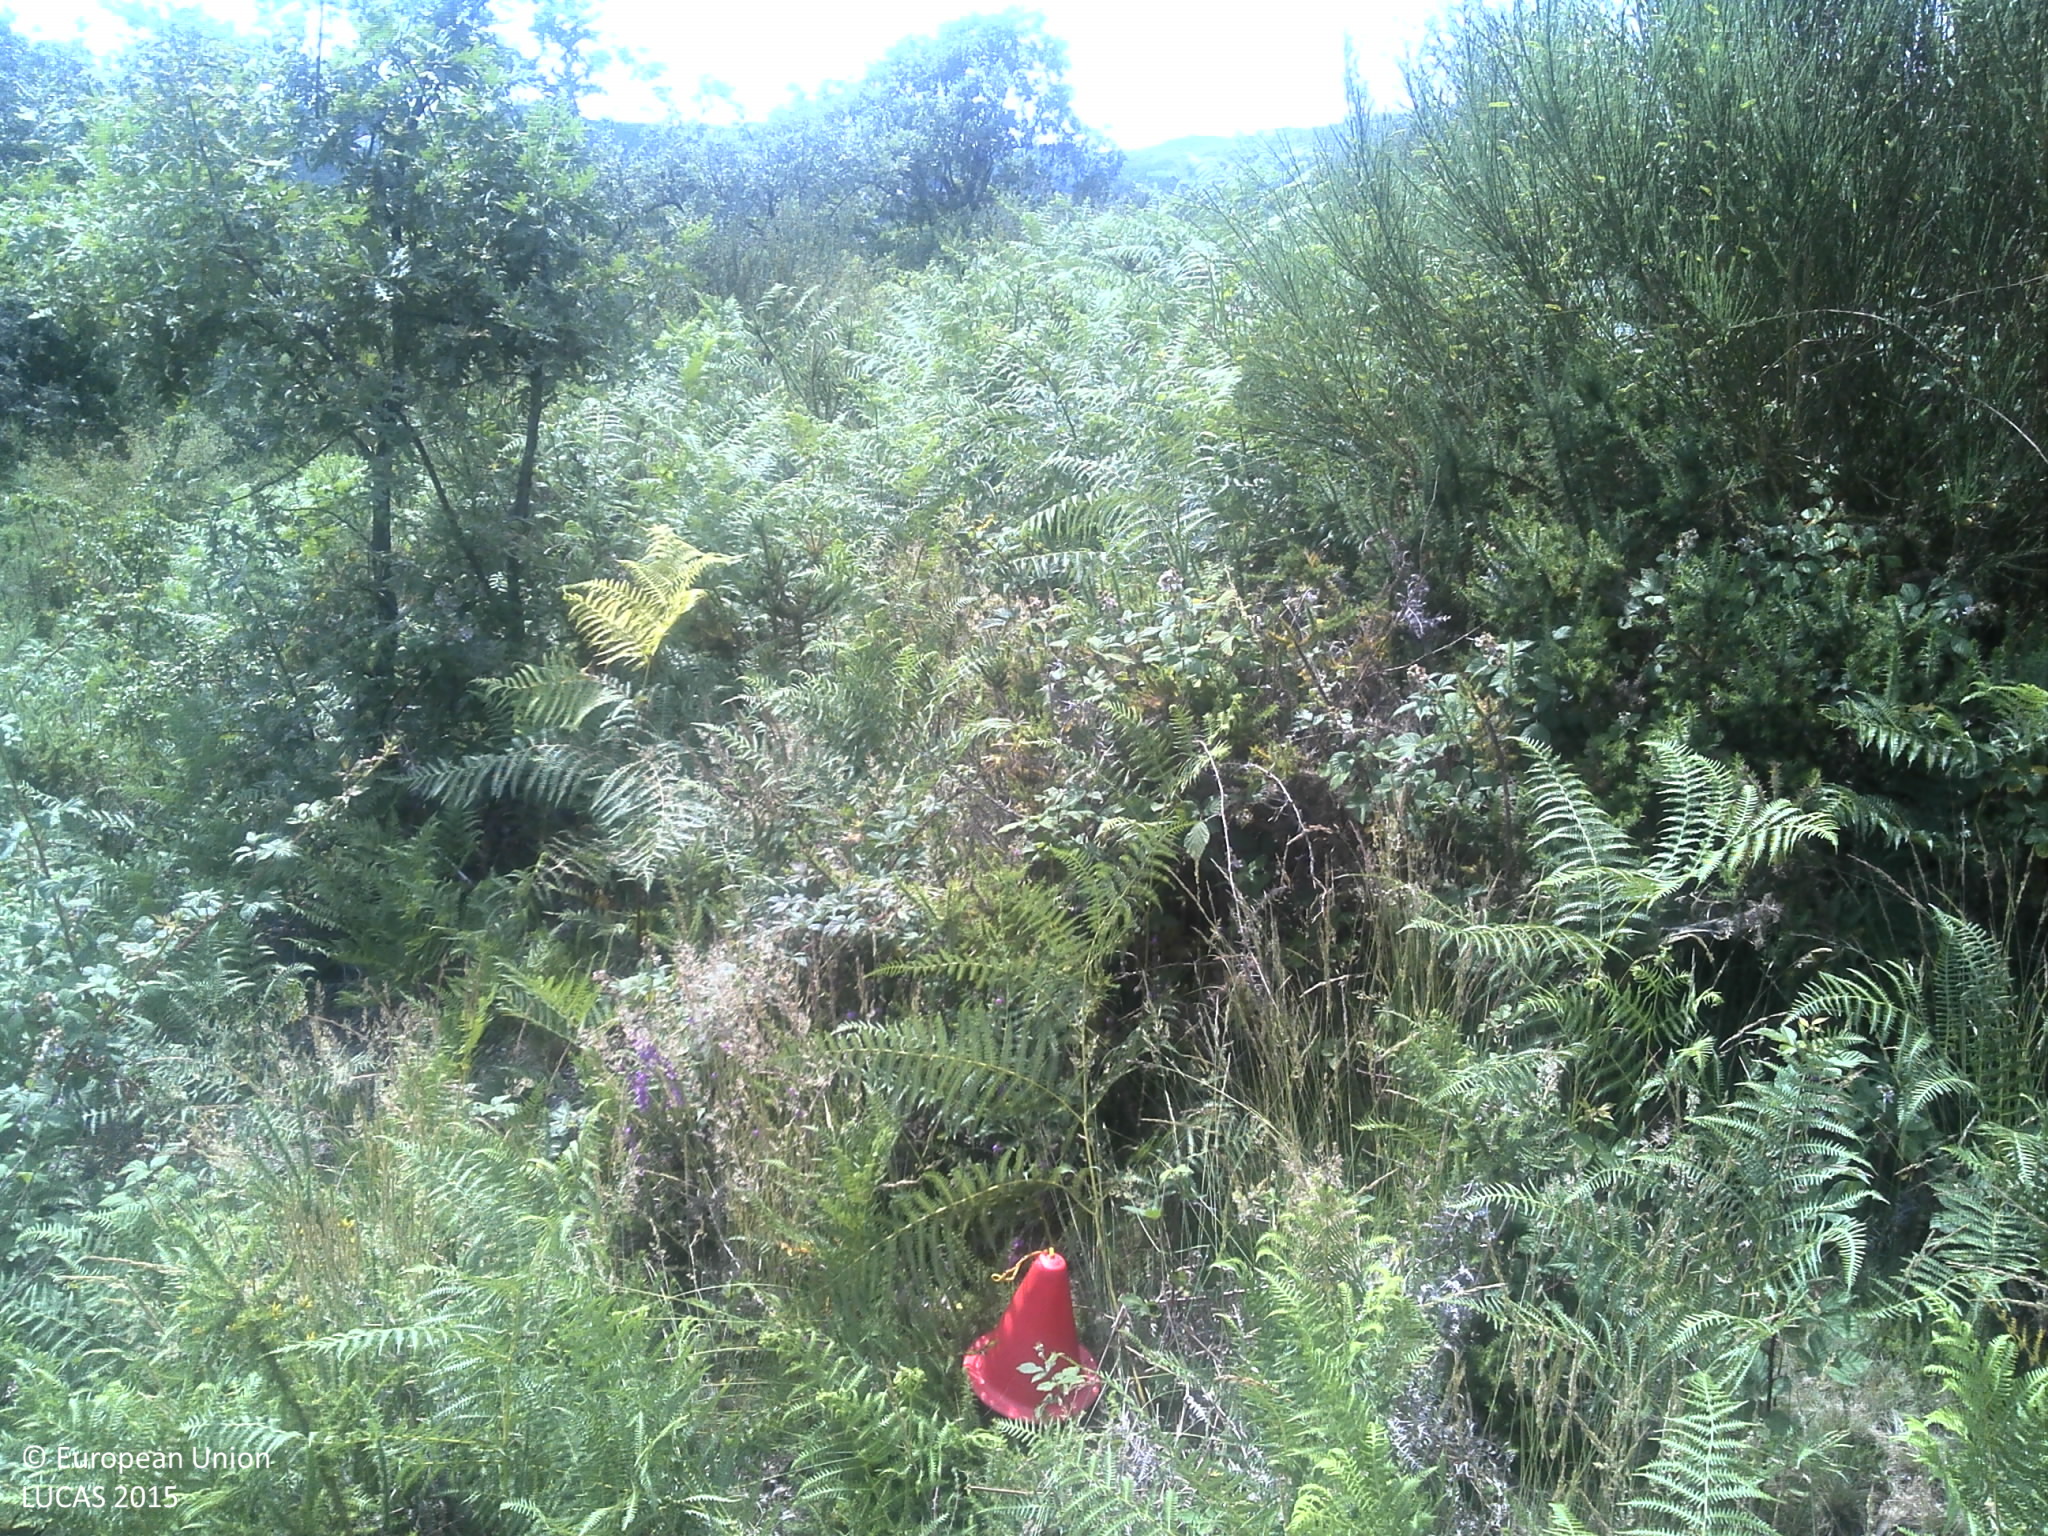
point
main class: Shrubland
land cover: Shrubland with sparse tree cover
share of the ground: > 75 %
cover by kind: shrubs 80 %, herbaceous plants 10 %, broadleaved forest trees 5 %, unconsolidated bare surface 5 %
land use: Semi-natural and natural areas not in use
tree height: > 5 m
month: June
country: PT
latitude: 41.6147
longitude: -8.2096
